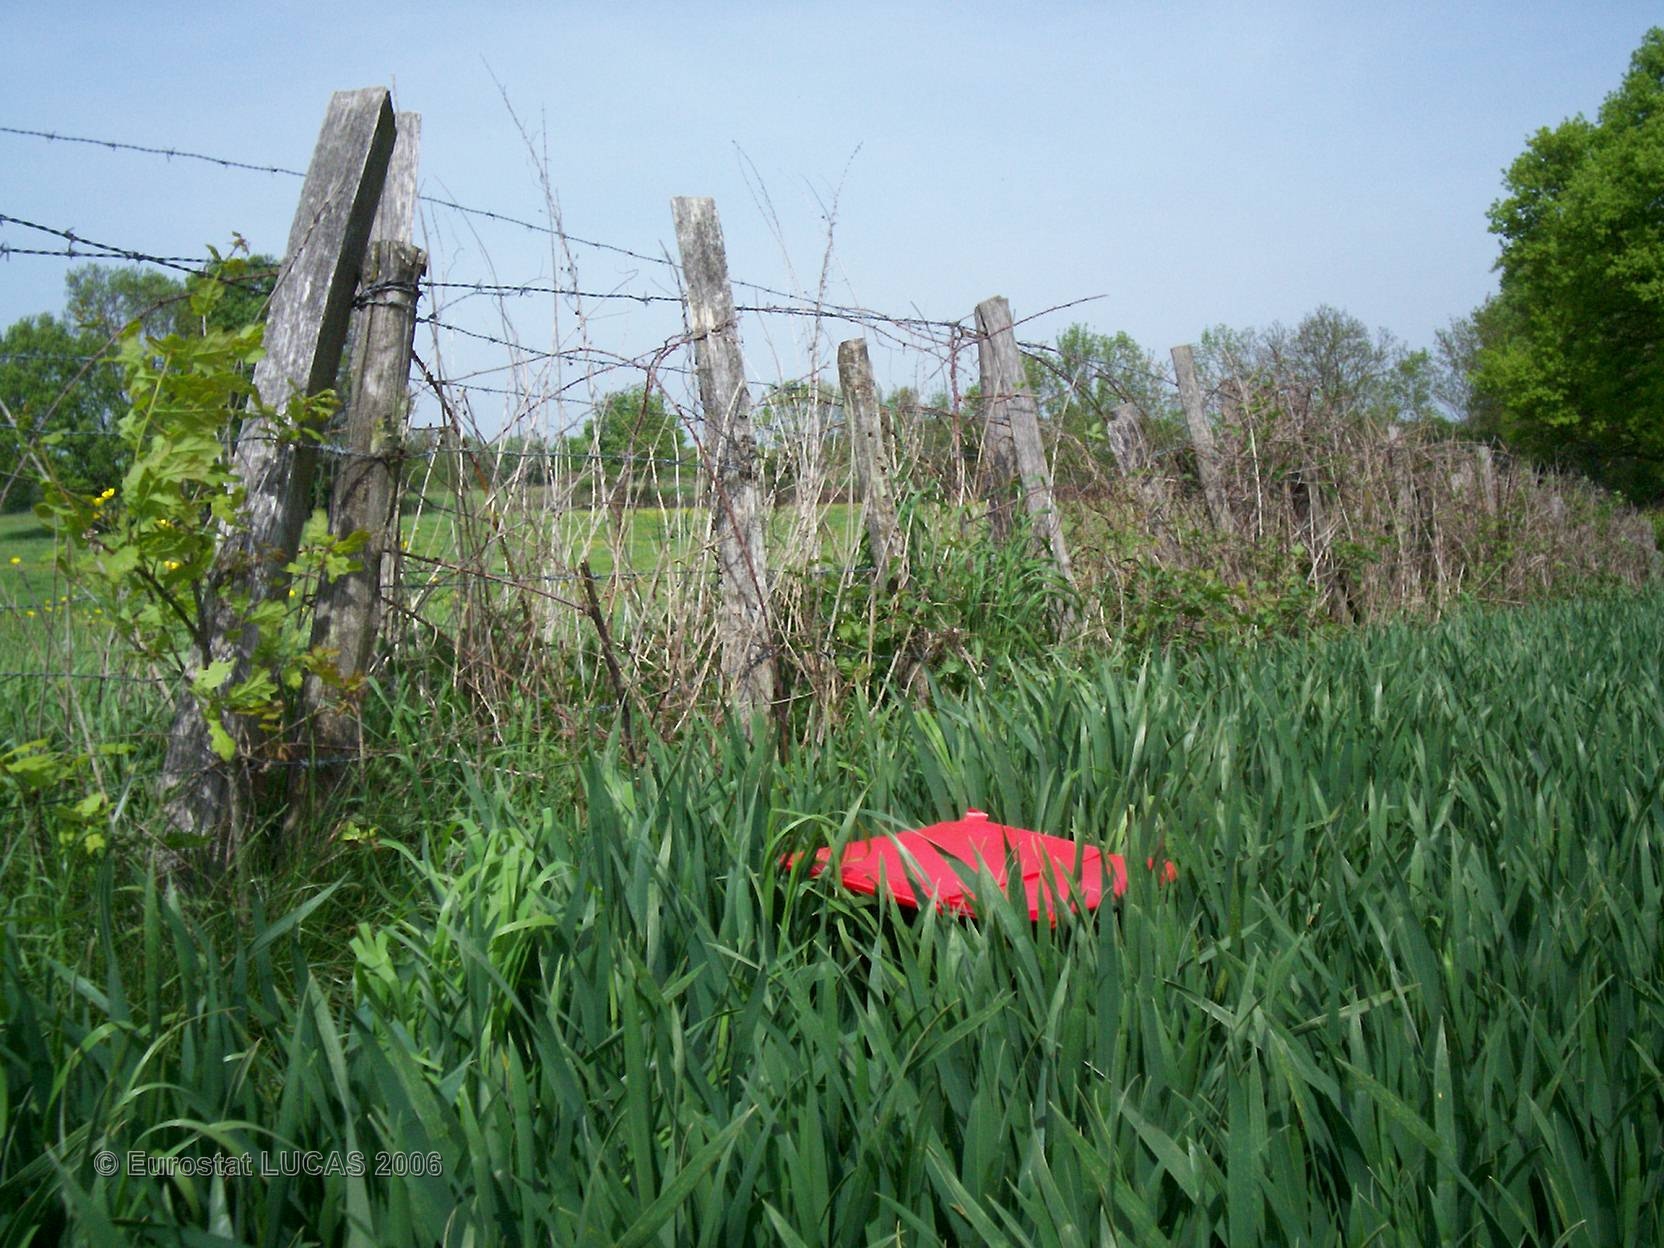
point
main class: Cropland
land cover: Common wheat
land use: Agriculture (excluding fallow land and kitchen gardens)
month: May
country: FR
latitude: 46.1915
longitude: 4.8586
